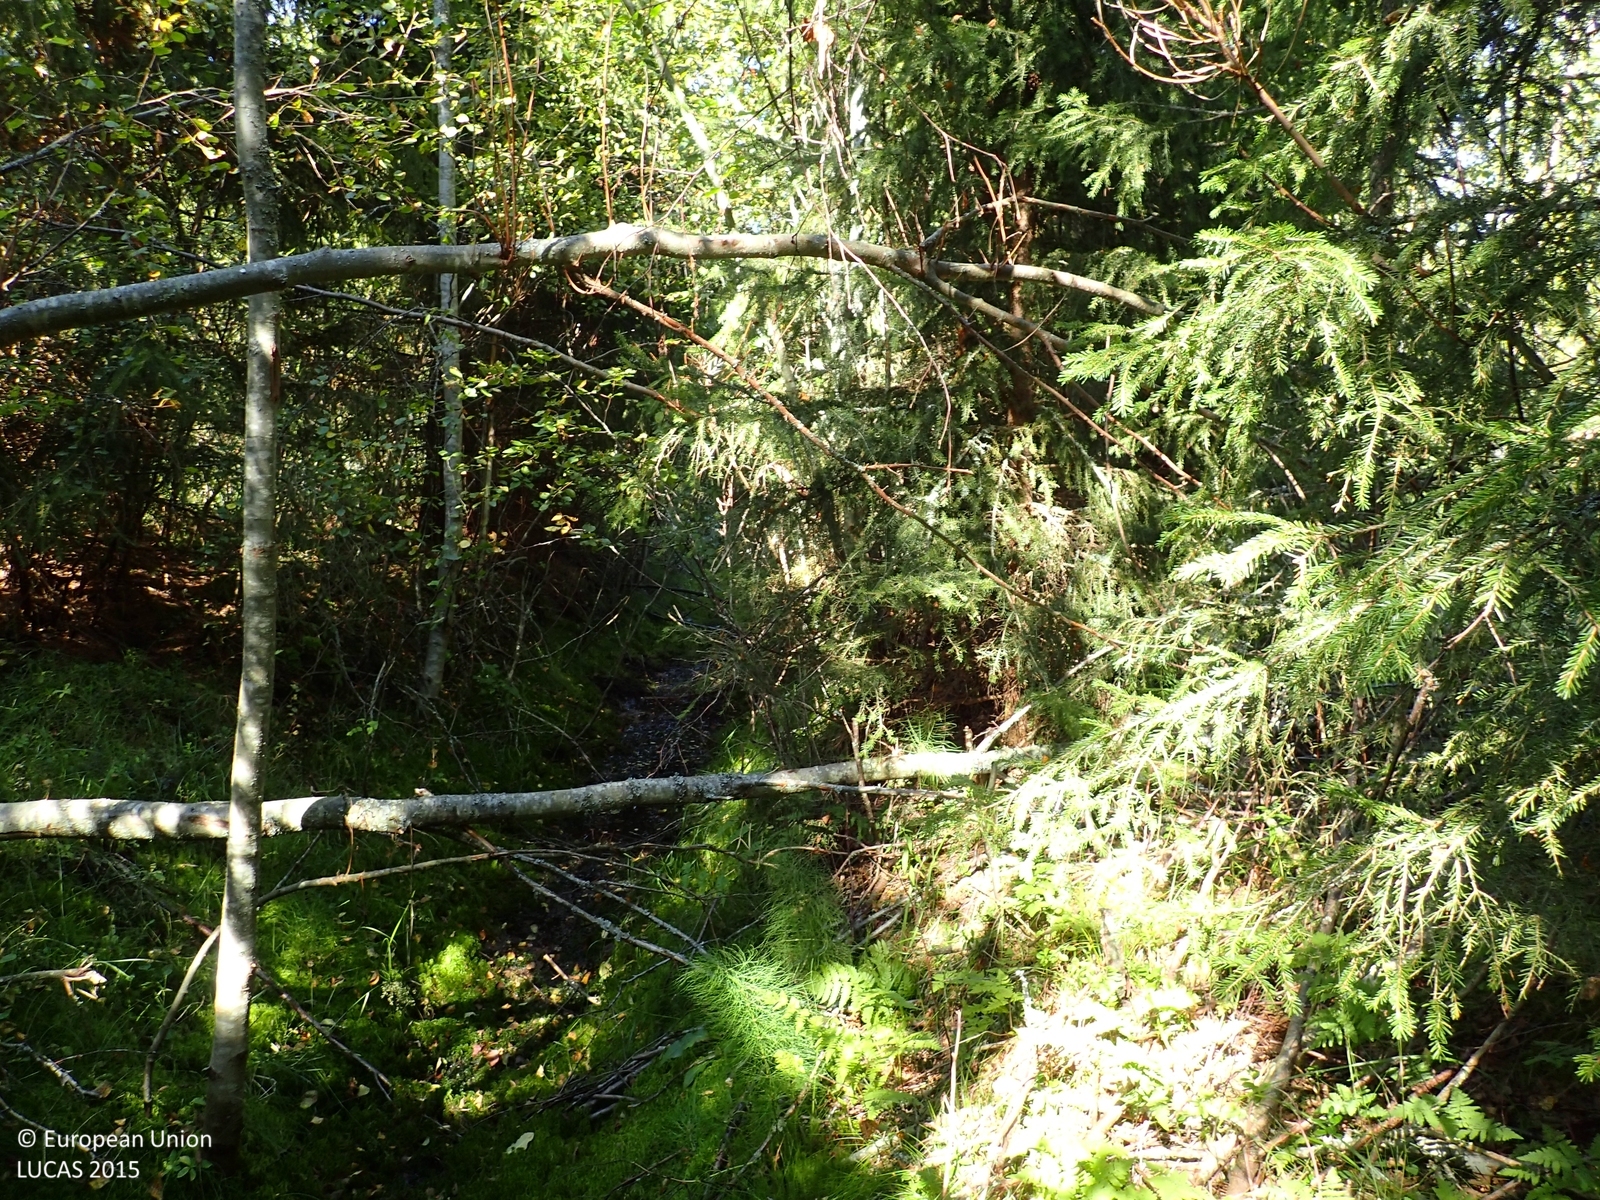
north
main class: Woodland
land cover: Spruce dominated mixed woodland
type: boreal forest
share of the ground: > 75 %
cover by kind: coniferous forest trees 60 %, broadleaved forest trees 20 %, herbaceous plants 10 %, lichens and mosses 10 %
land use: Forestry
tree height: > 5 m
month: August
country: FI
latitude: 62.5979
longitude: 21.8690
